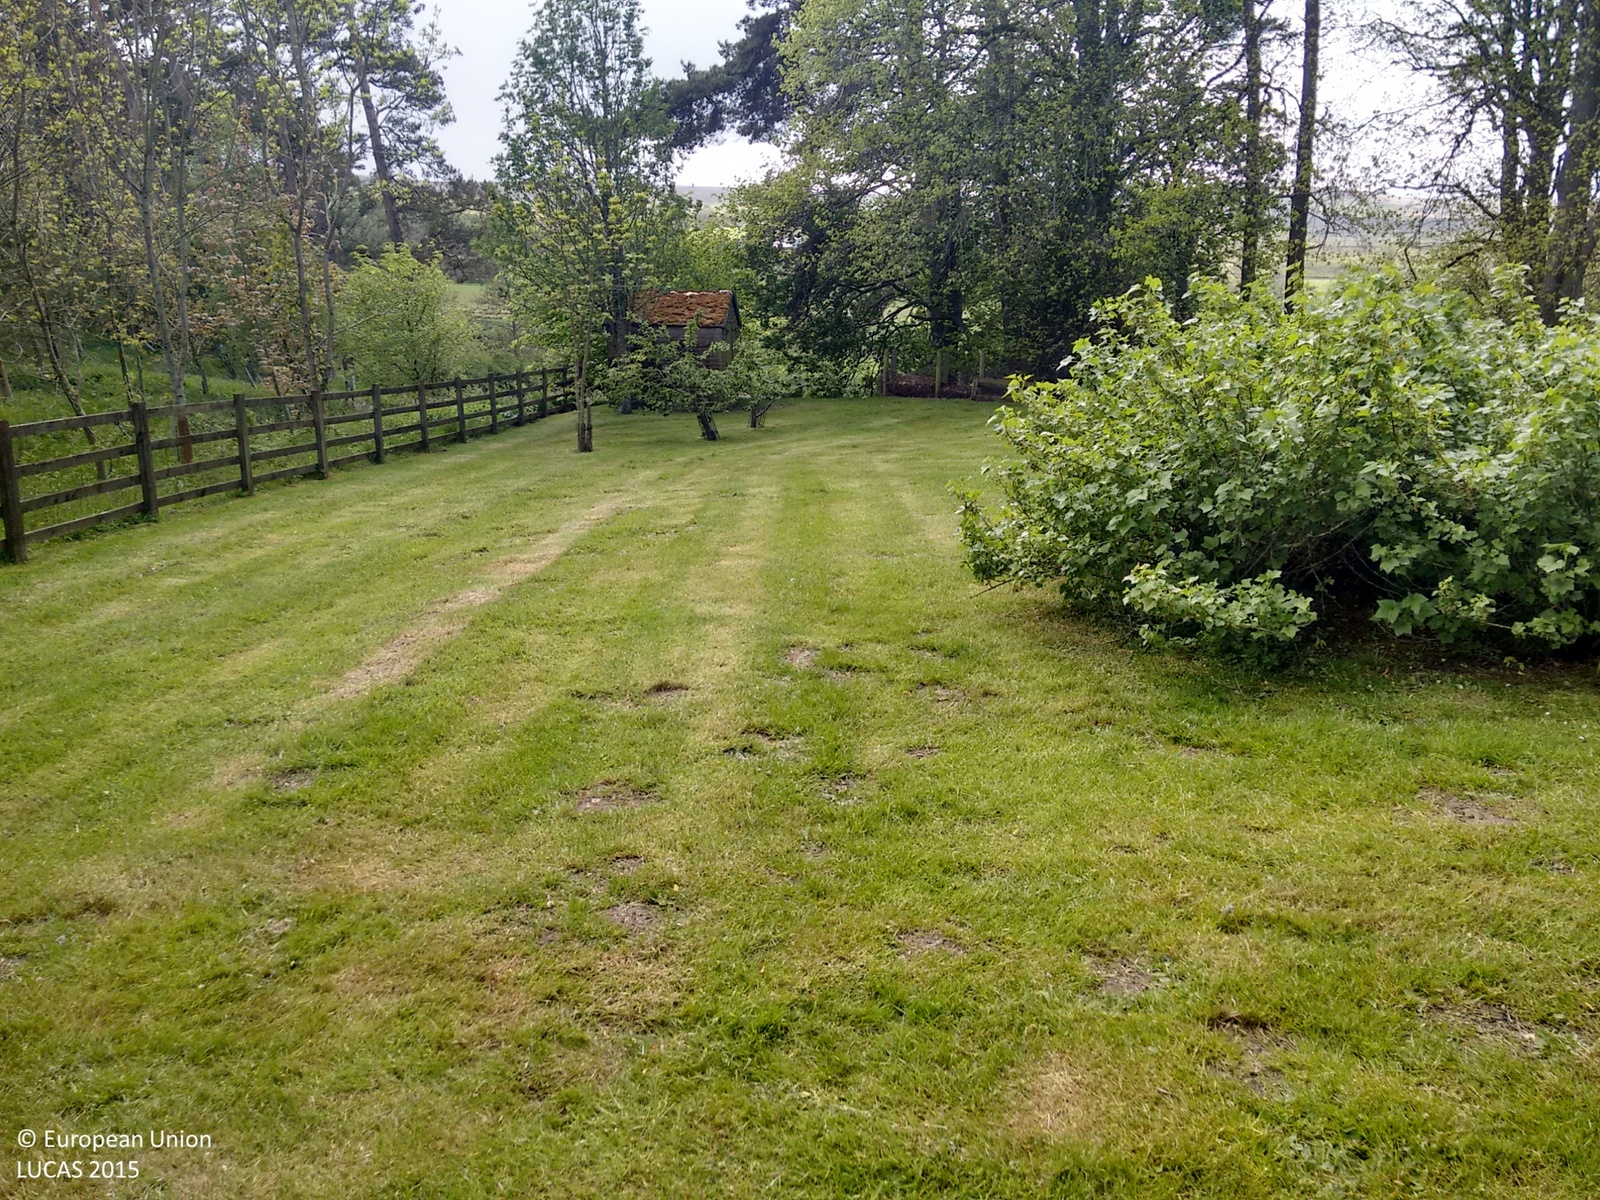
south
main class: Grassland
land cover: Grassland with sparse tree/shrub cover
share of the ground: > 75 %
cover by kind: herbaceous plants 95 %, broadleaved forest trees 5 %
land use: Residential
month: May
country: GB
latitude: 55.1547
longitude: -2.3157
